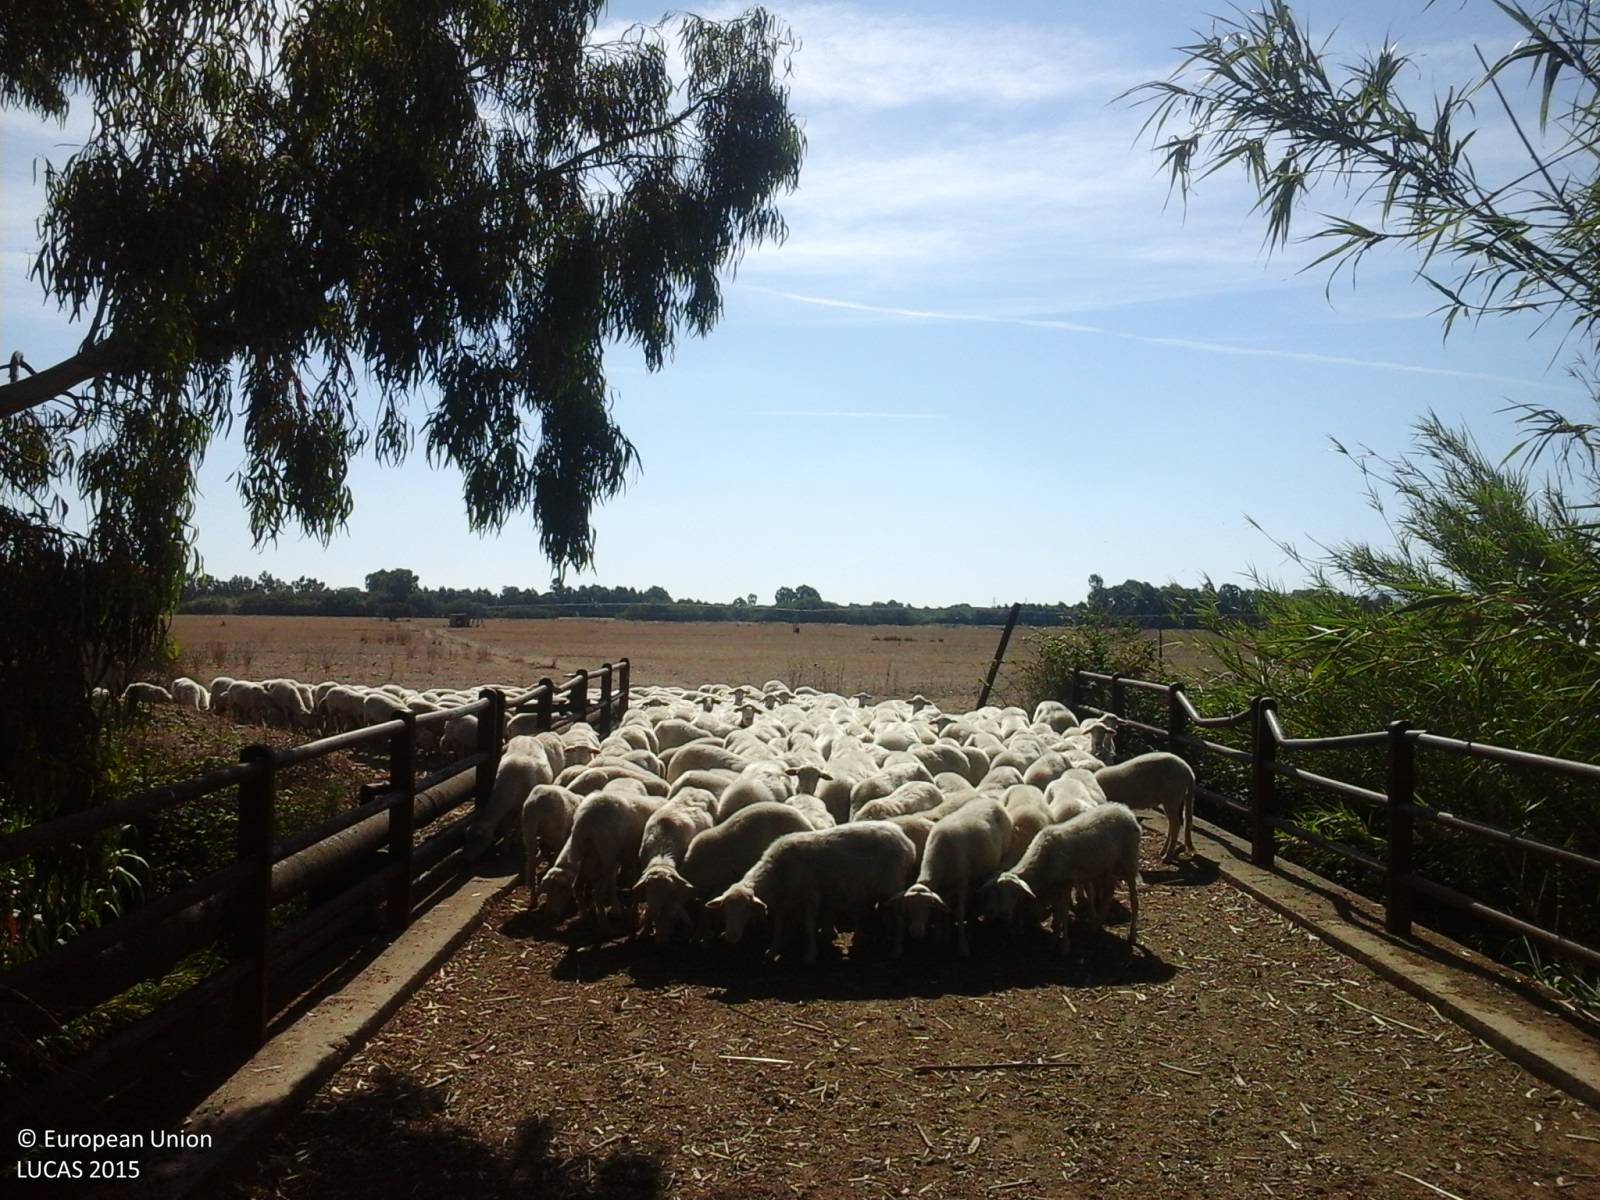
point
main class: Cropland
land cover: Temporary grasslands
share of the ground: > 75 %
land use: Agriculture (excluding fallow land and kitchen gardens)
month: June
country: IT
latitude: 39.2980
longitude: 8.6516
